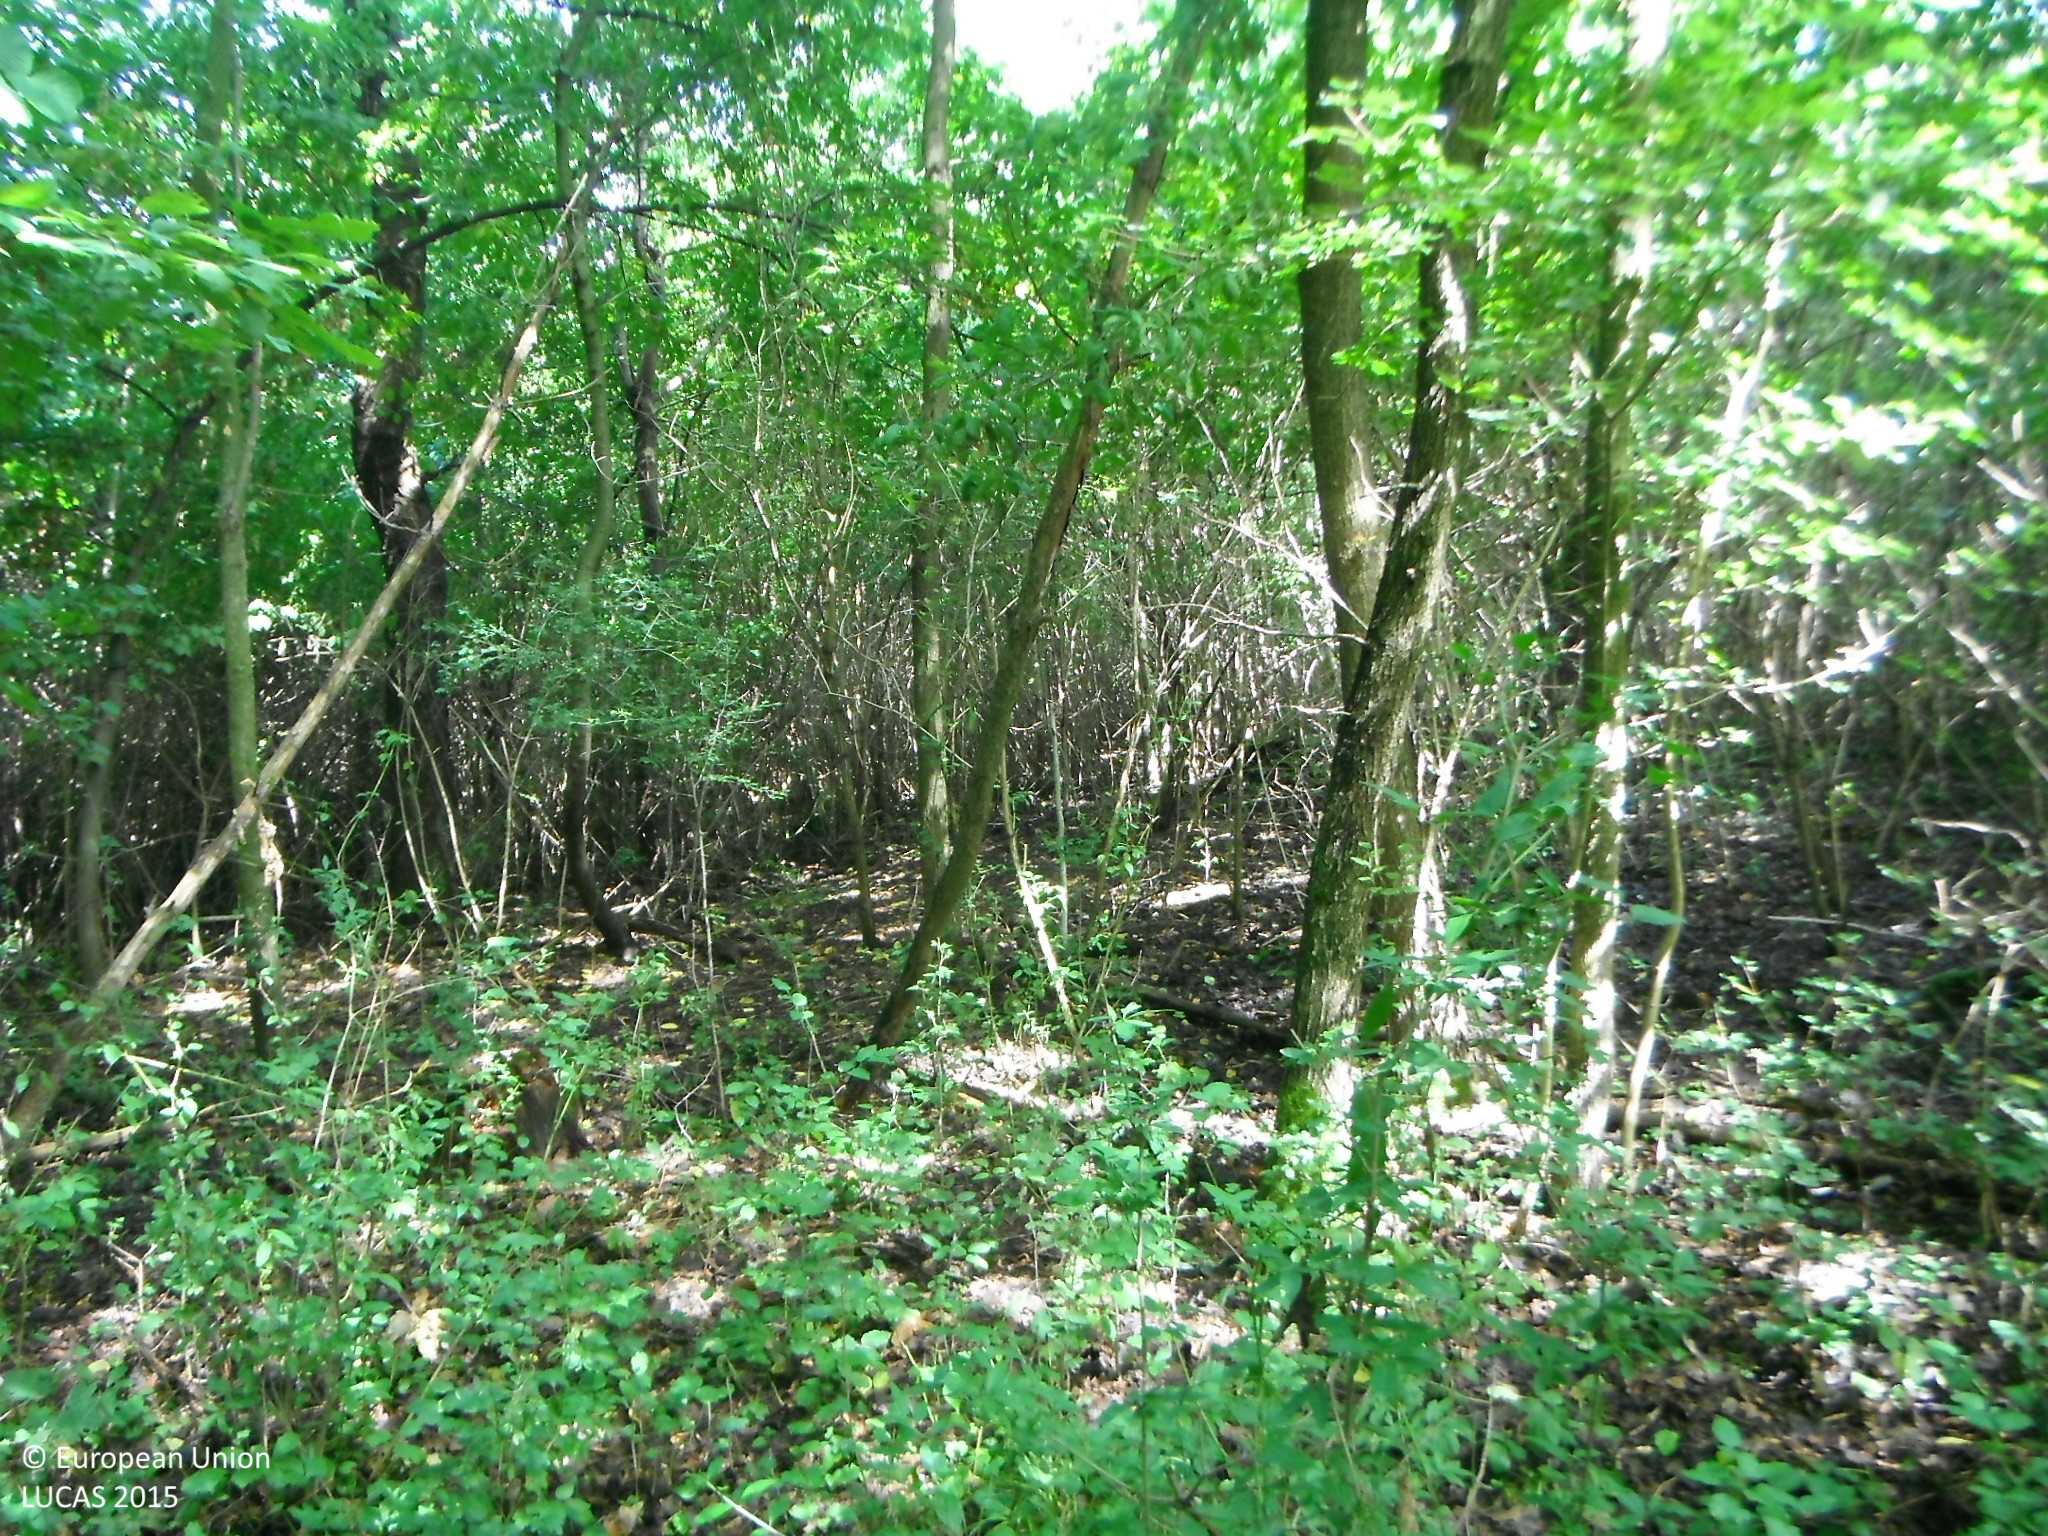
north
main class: Woodland
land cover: Broadleaved woodland
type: mesophytic deciduous forest
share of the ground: > 75 %
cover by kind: broadleaved forest trees 80 %, shrubs 10 %, herbaceous plants 10 %
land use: Forestry
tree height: > 5 m
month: July
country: SK
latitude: 48.6668
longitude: 18.3396
